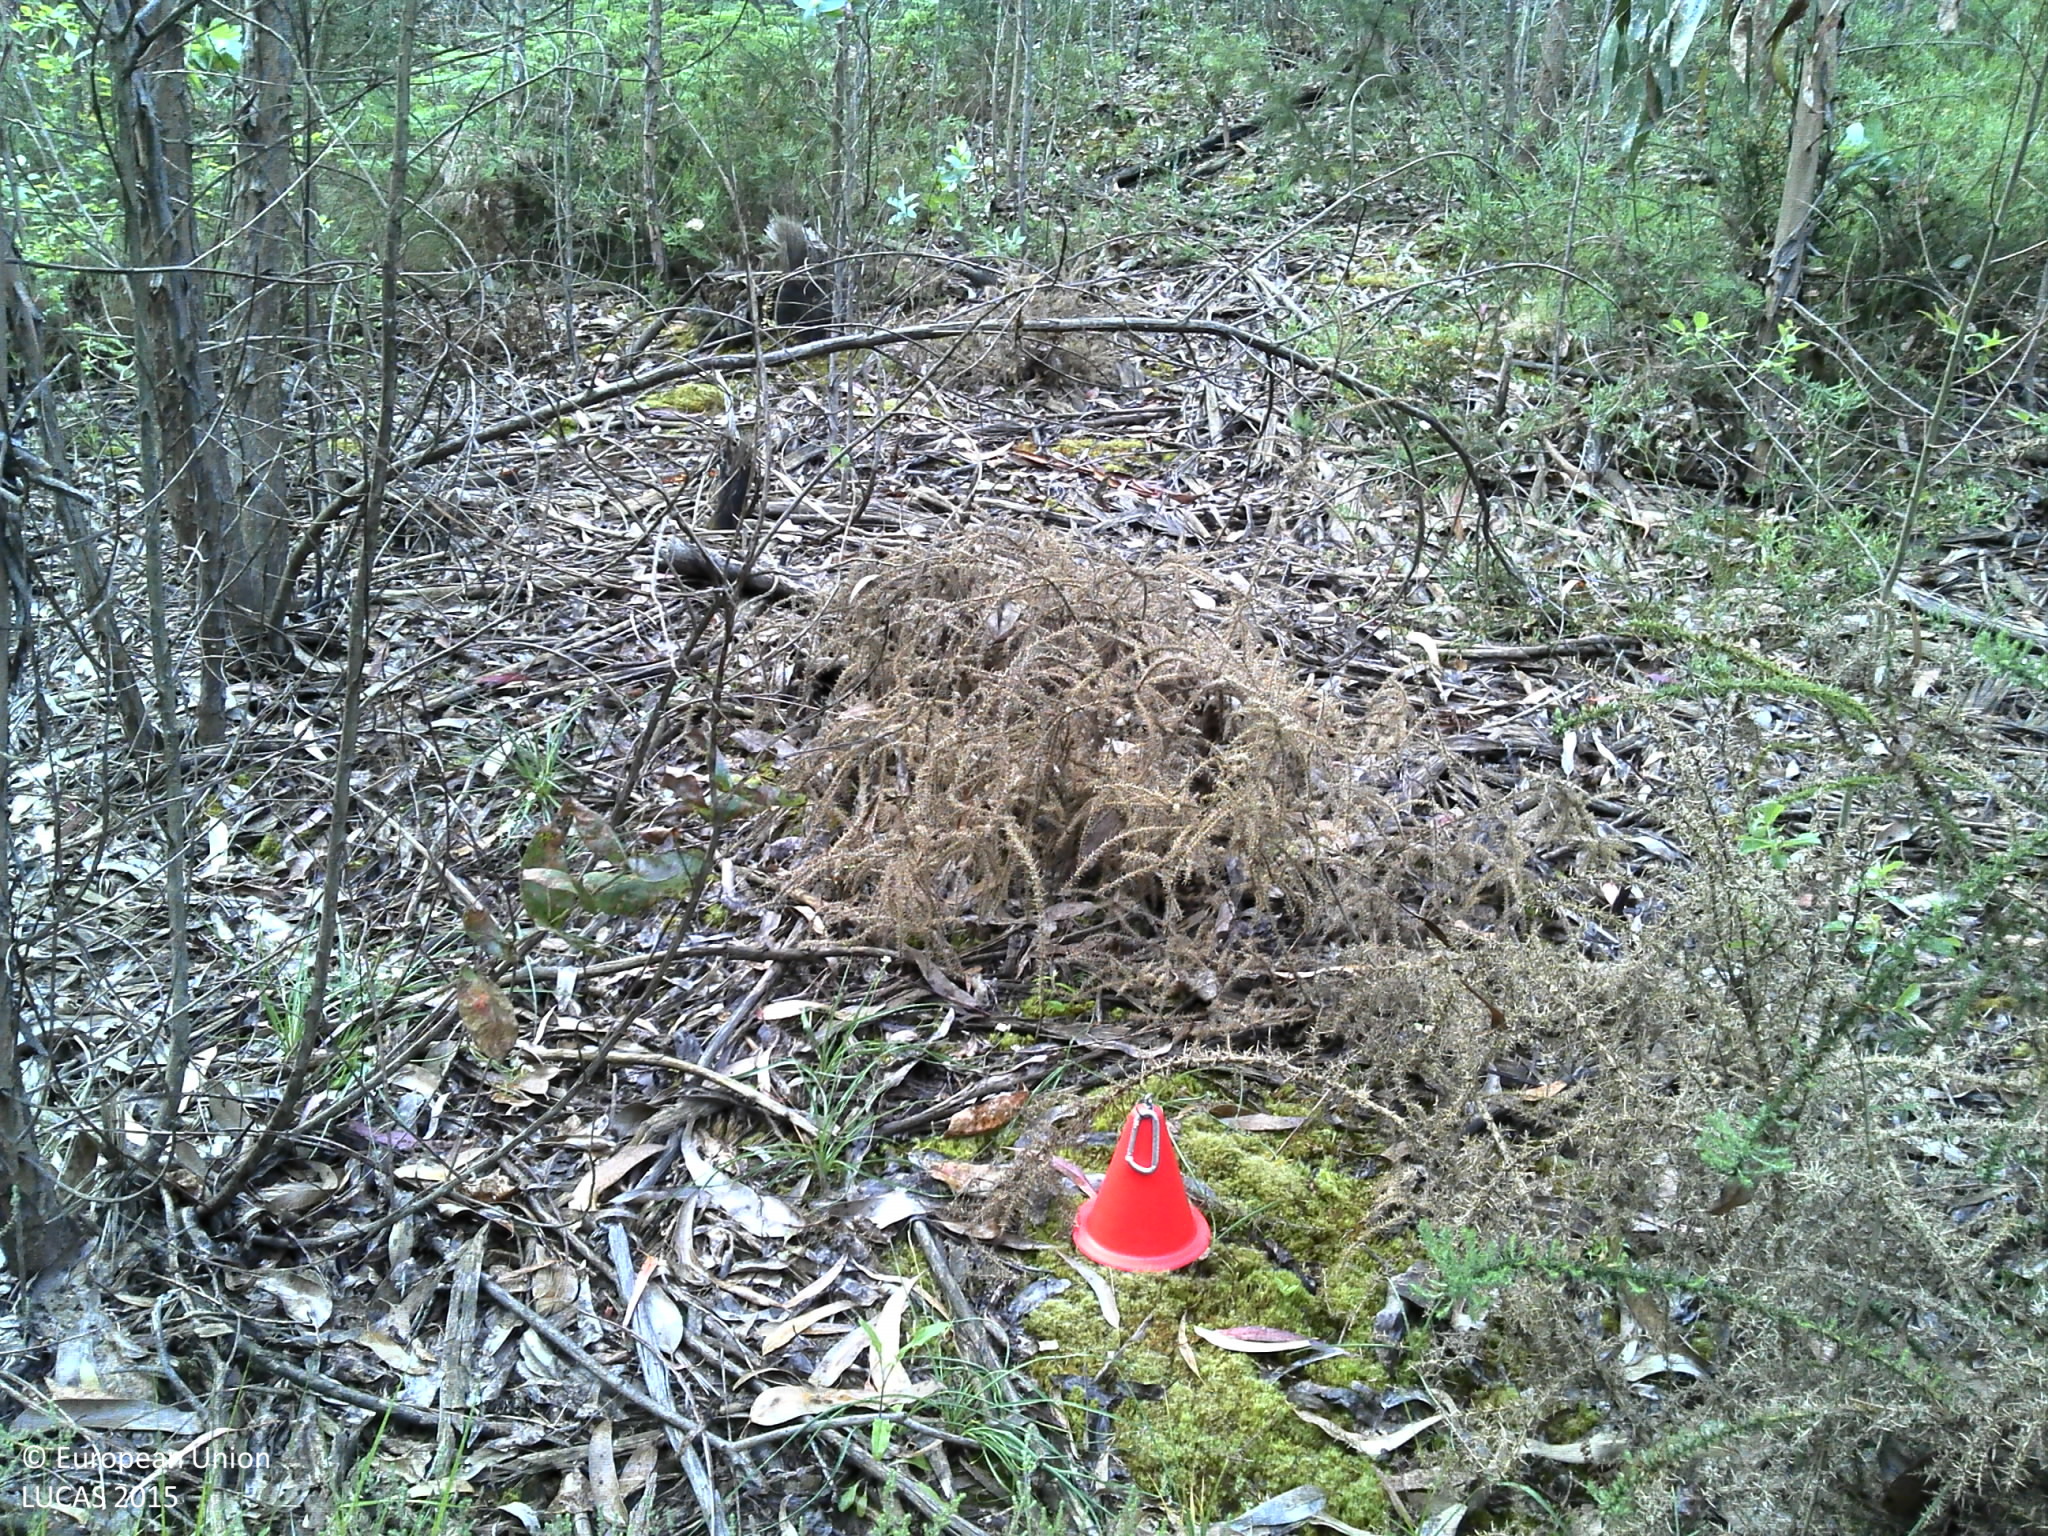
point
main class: Woodland
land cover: Broadleaved woodland
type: exotic forest
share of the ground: 50 - 75 %
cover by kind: broadleaved forest trees 60 %, shrubs 30 %, herbaceous plants 5 %, unconsolidated bare surface 5 %
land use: Forestry
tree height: < 5 m
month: May
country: PT
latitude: 41.2128
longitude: -8.4816
